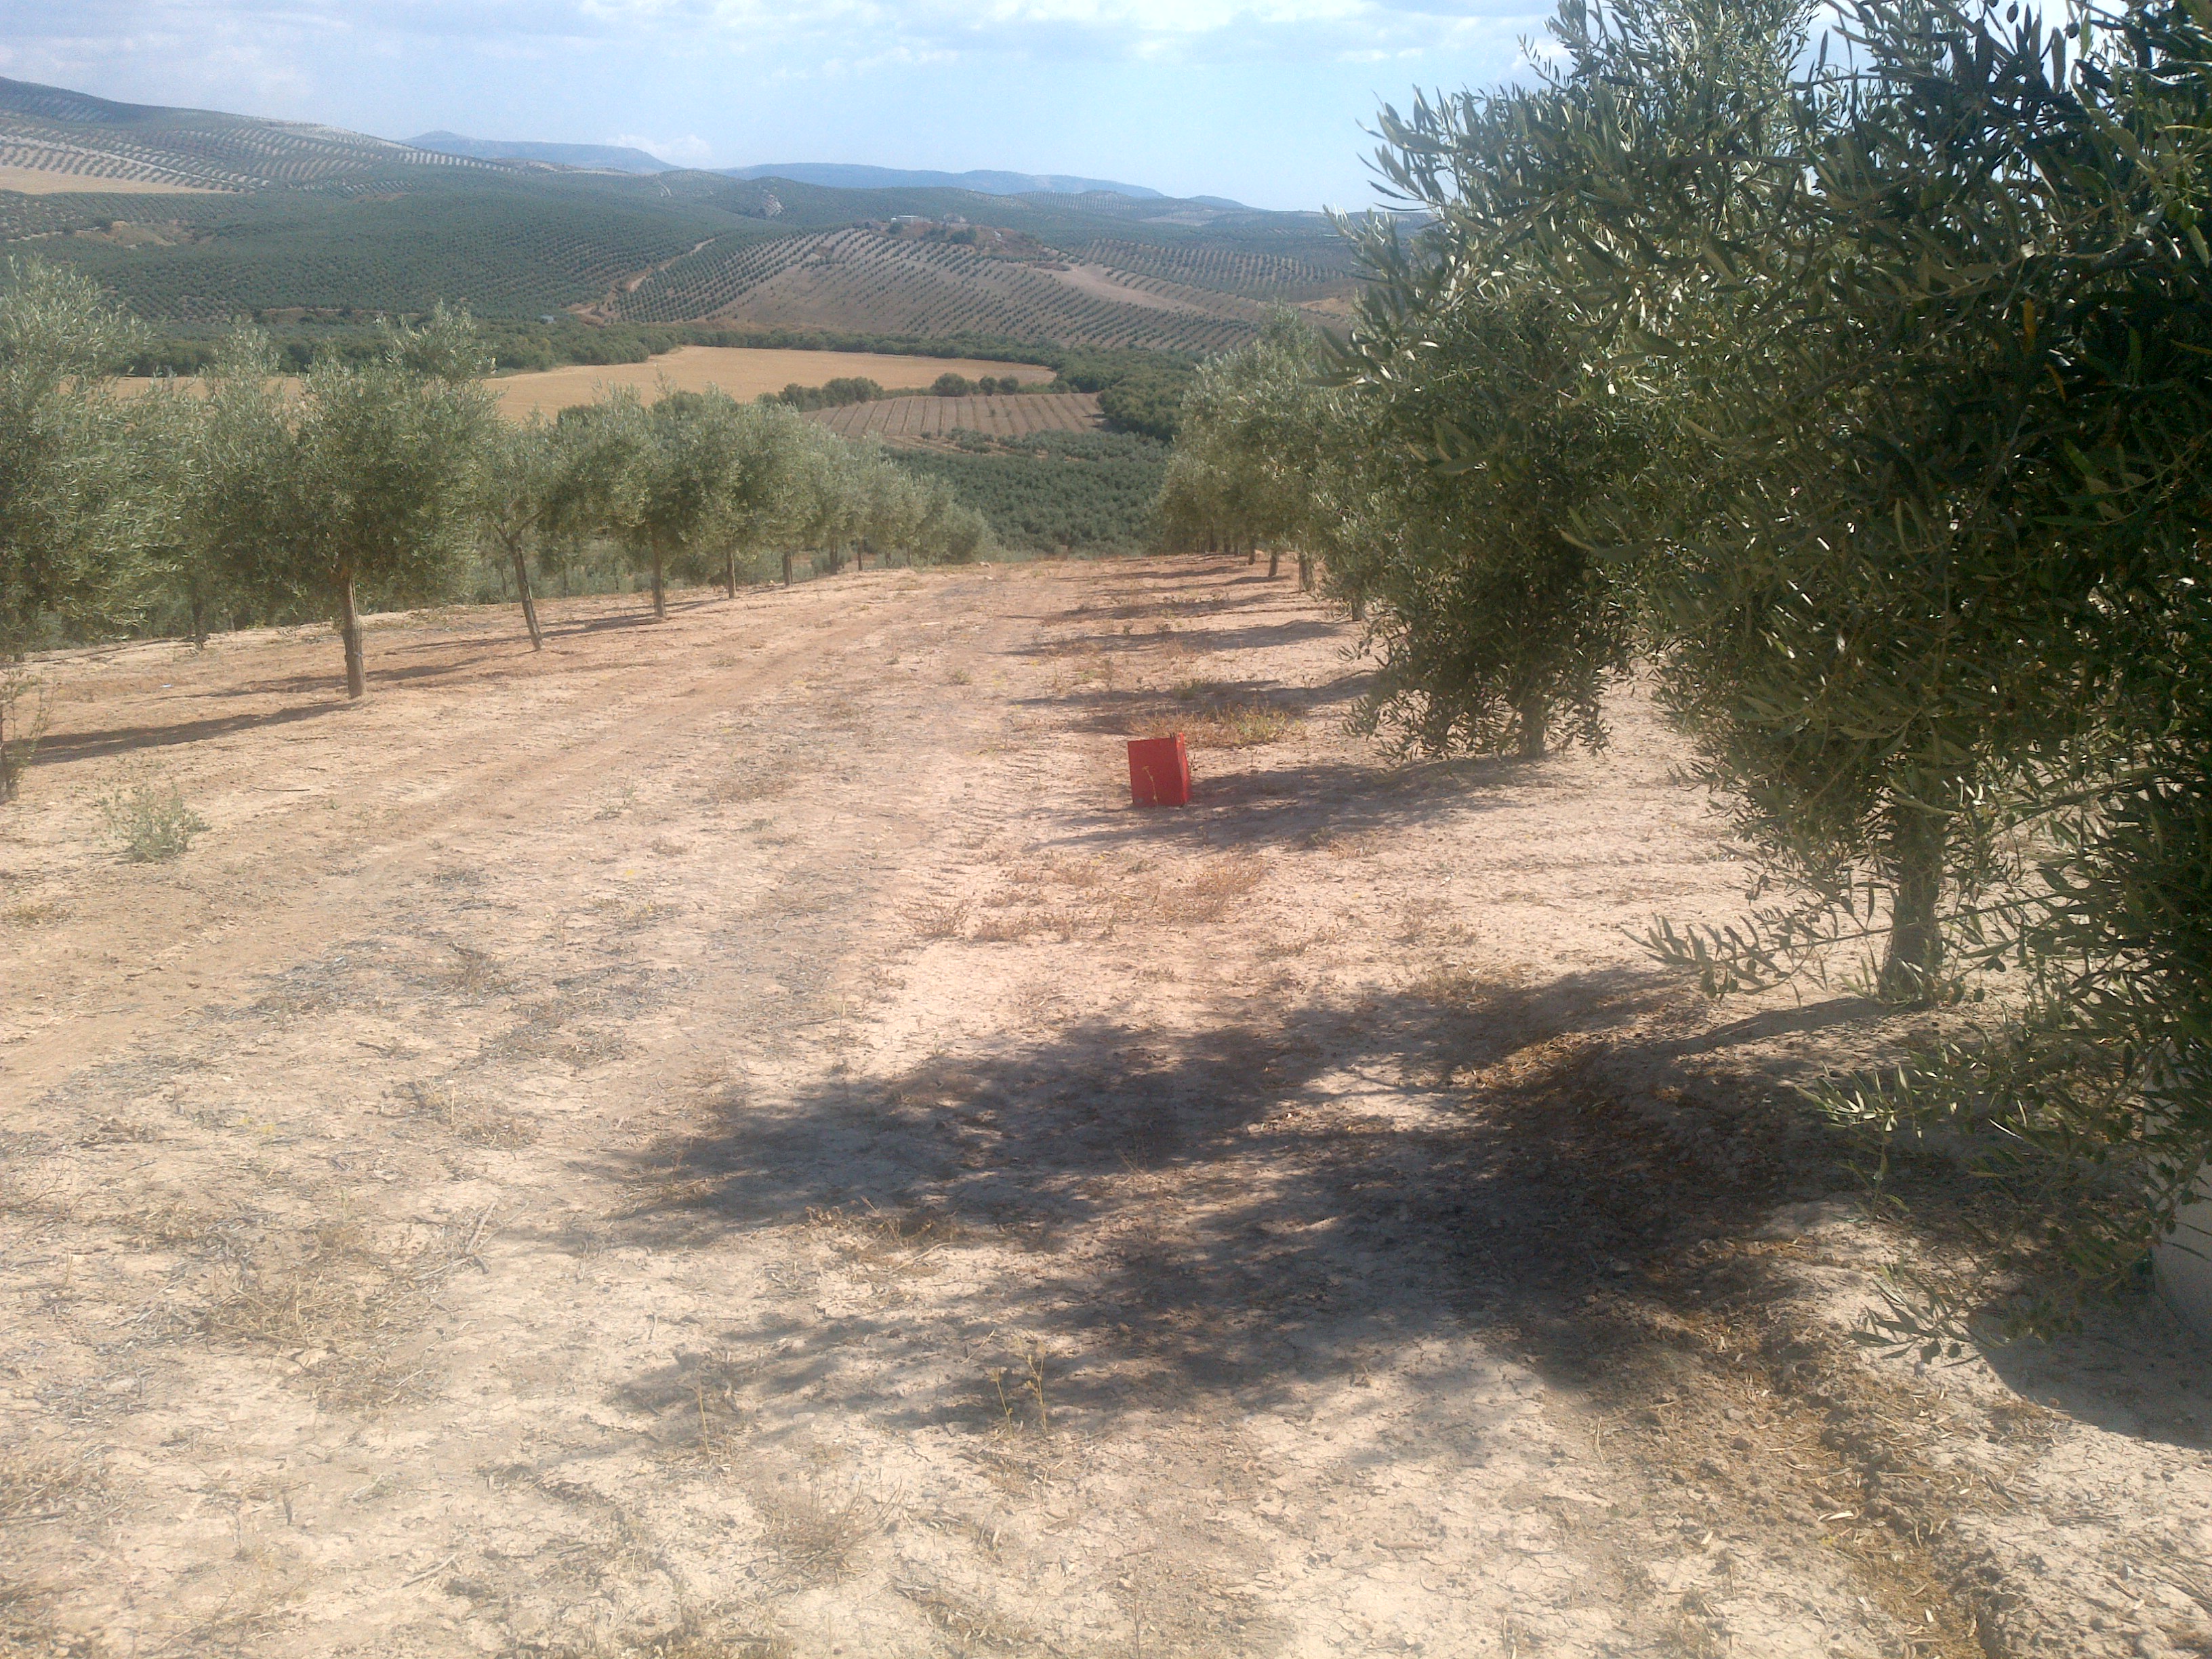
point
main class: Cropland
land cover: Olive groves
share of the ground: 10 - 25 %
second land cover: Other bare soil
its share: > 75 %
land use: Agriculture (excluding fallow land and kitchen gardens)
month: June
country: ES
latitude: 37.6926
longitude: -4.2829
